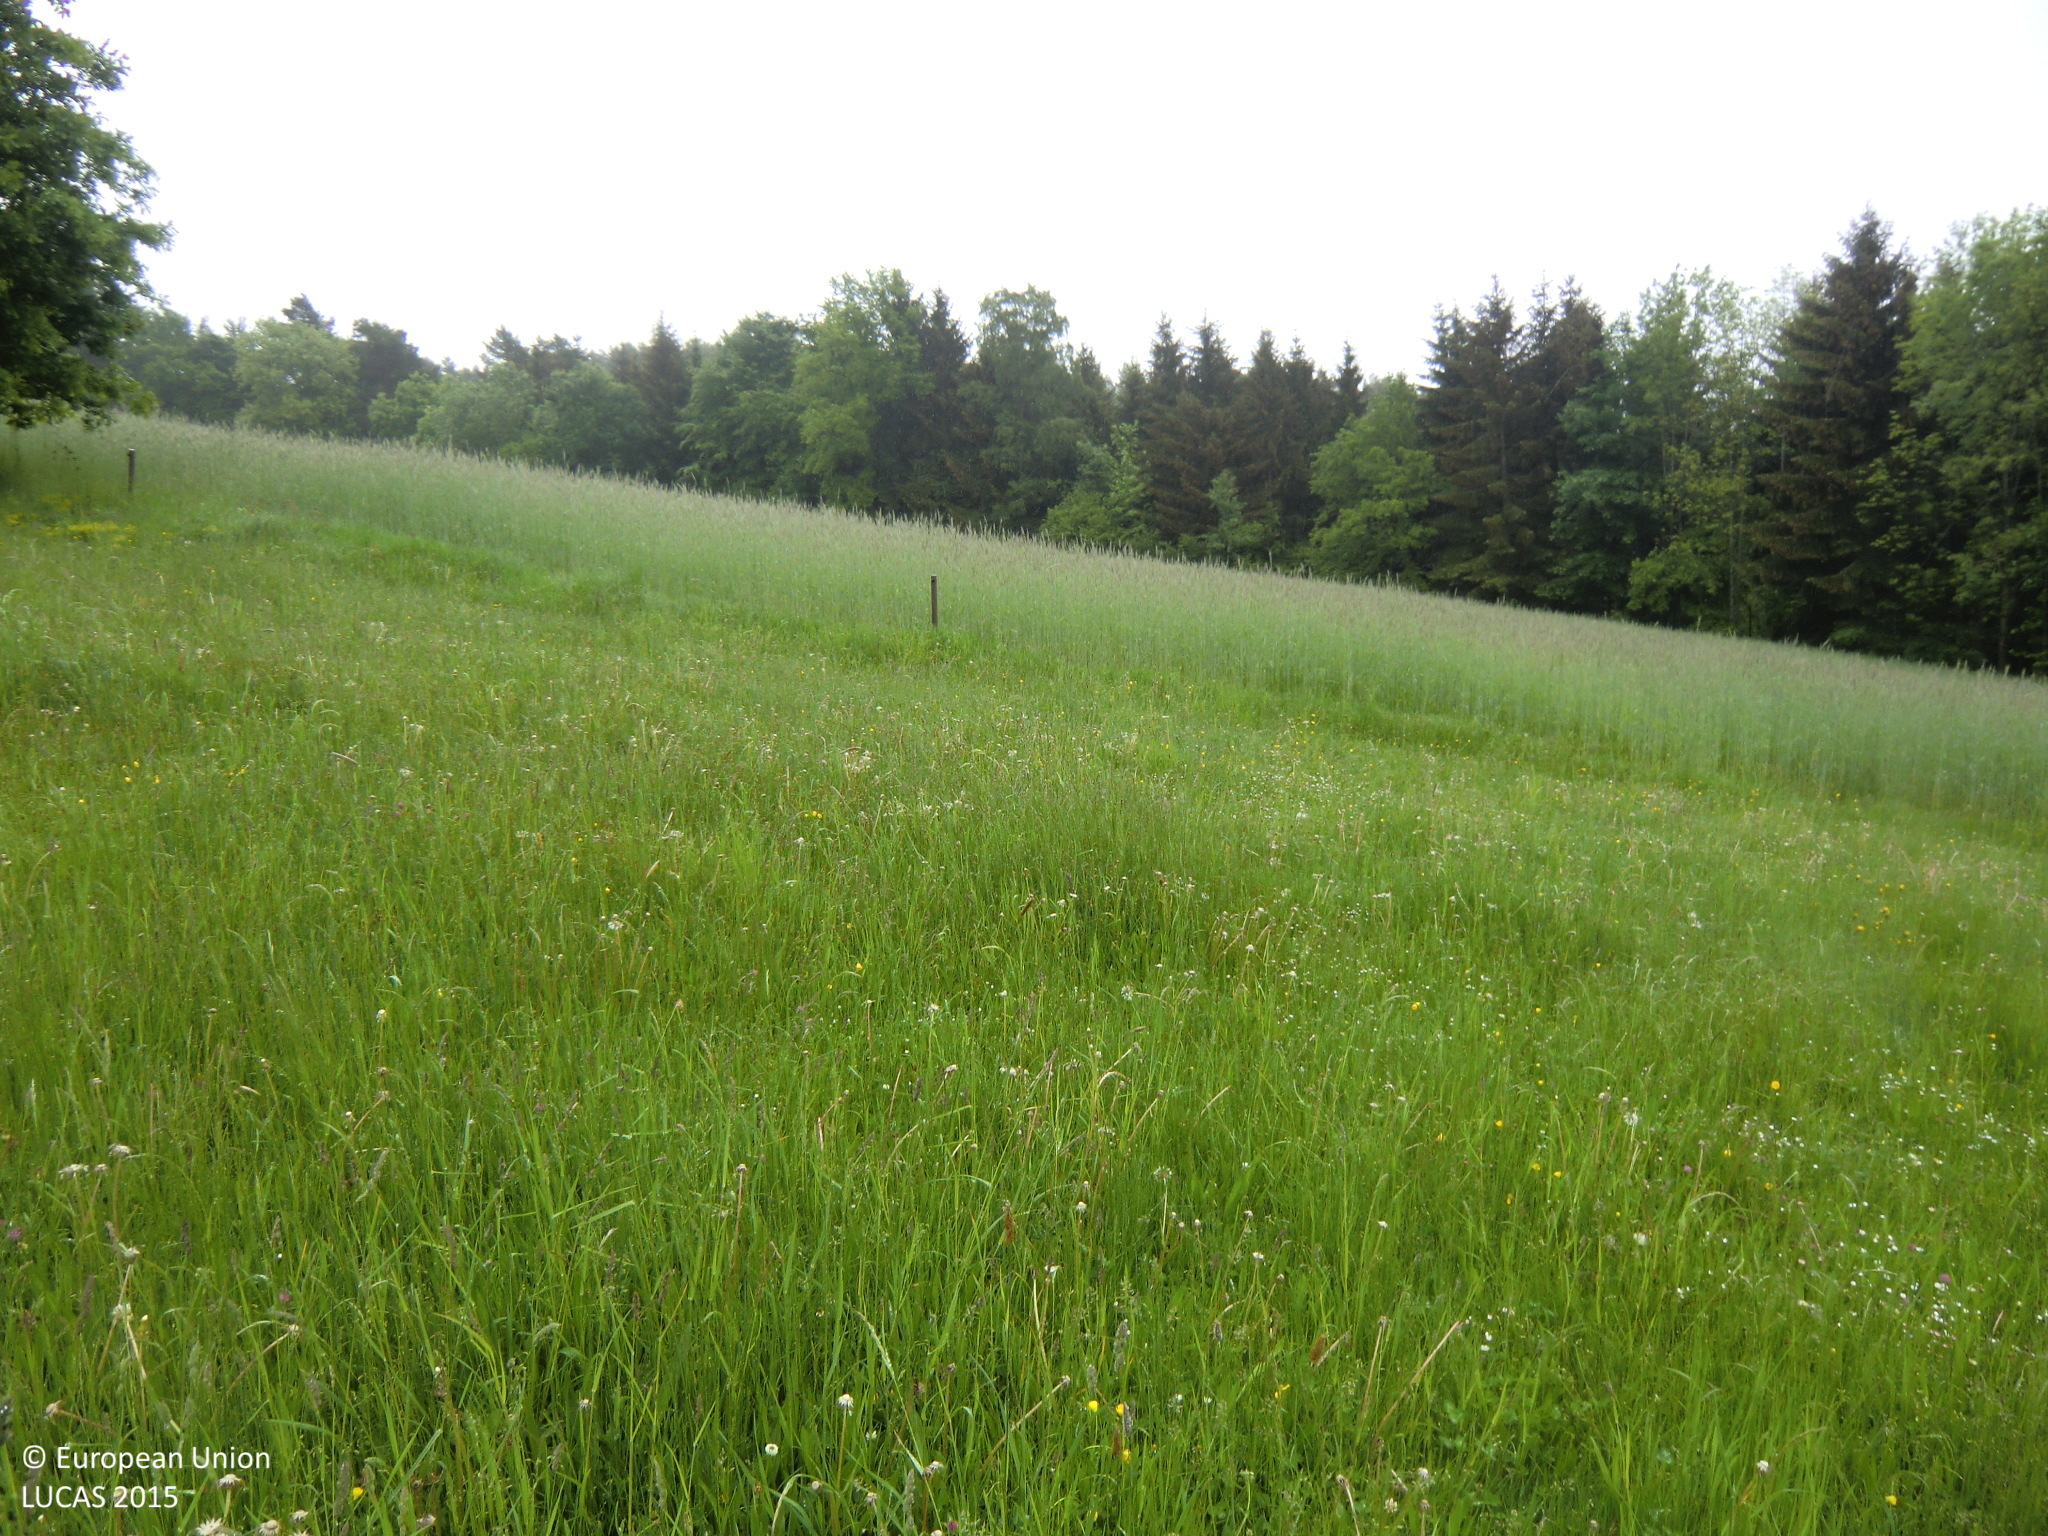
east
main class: Grassland
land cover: Grassland without tree/shrub cover
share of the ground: > 75 %
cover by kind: herbaceous plants 100 %
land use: Agriculture (excluding fallow land and kitchen gardens)
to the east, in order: Grassland without tree/shrub cover; Broadleaved woodland; Rye; Tracks; Groves; Spruce dominated coniferous woodland; Broadleaved woodland; Grassland without tree/shrub cover; Tracks; Grassland without tree/shrub cover; Ditches and canals; Grassland without tree/shrub cover; Pine dominated mixed woodland
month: May
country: AT
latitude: 48.4233
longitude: 14.4193
